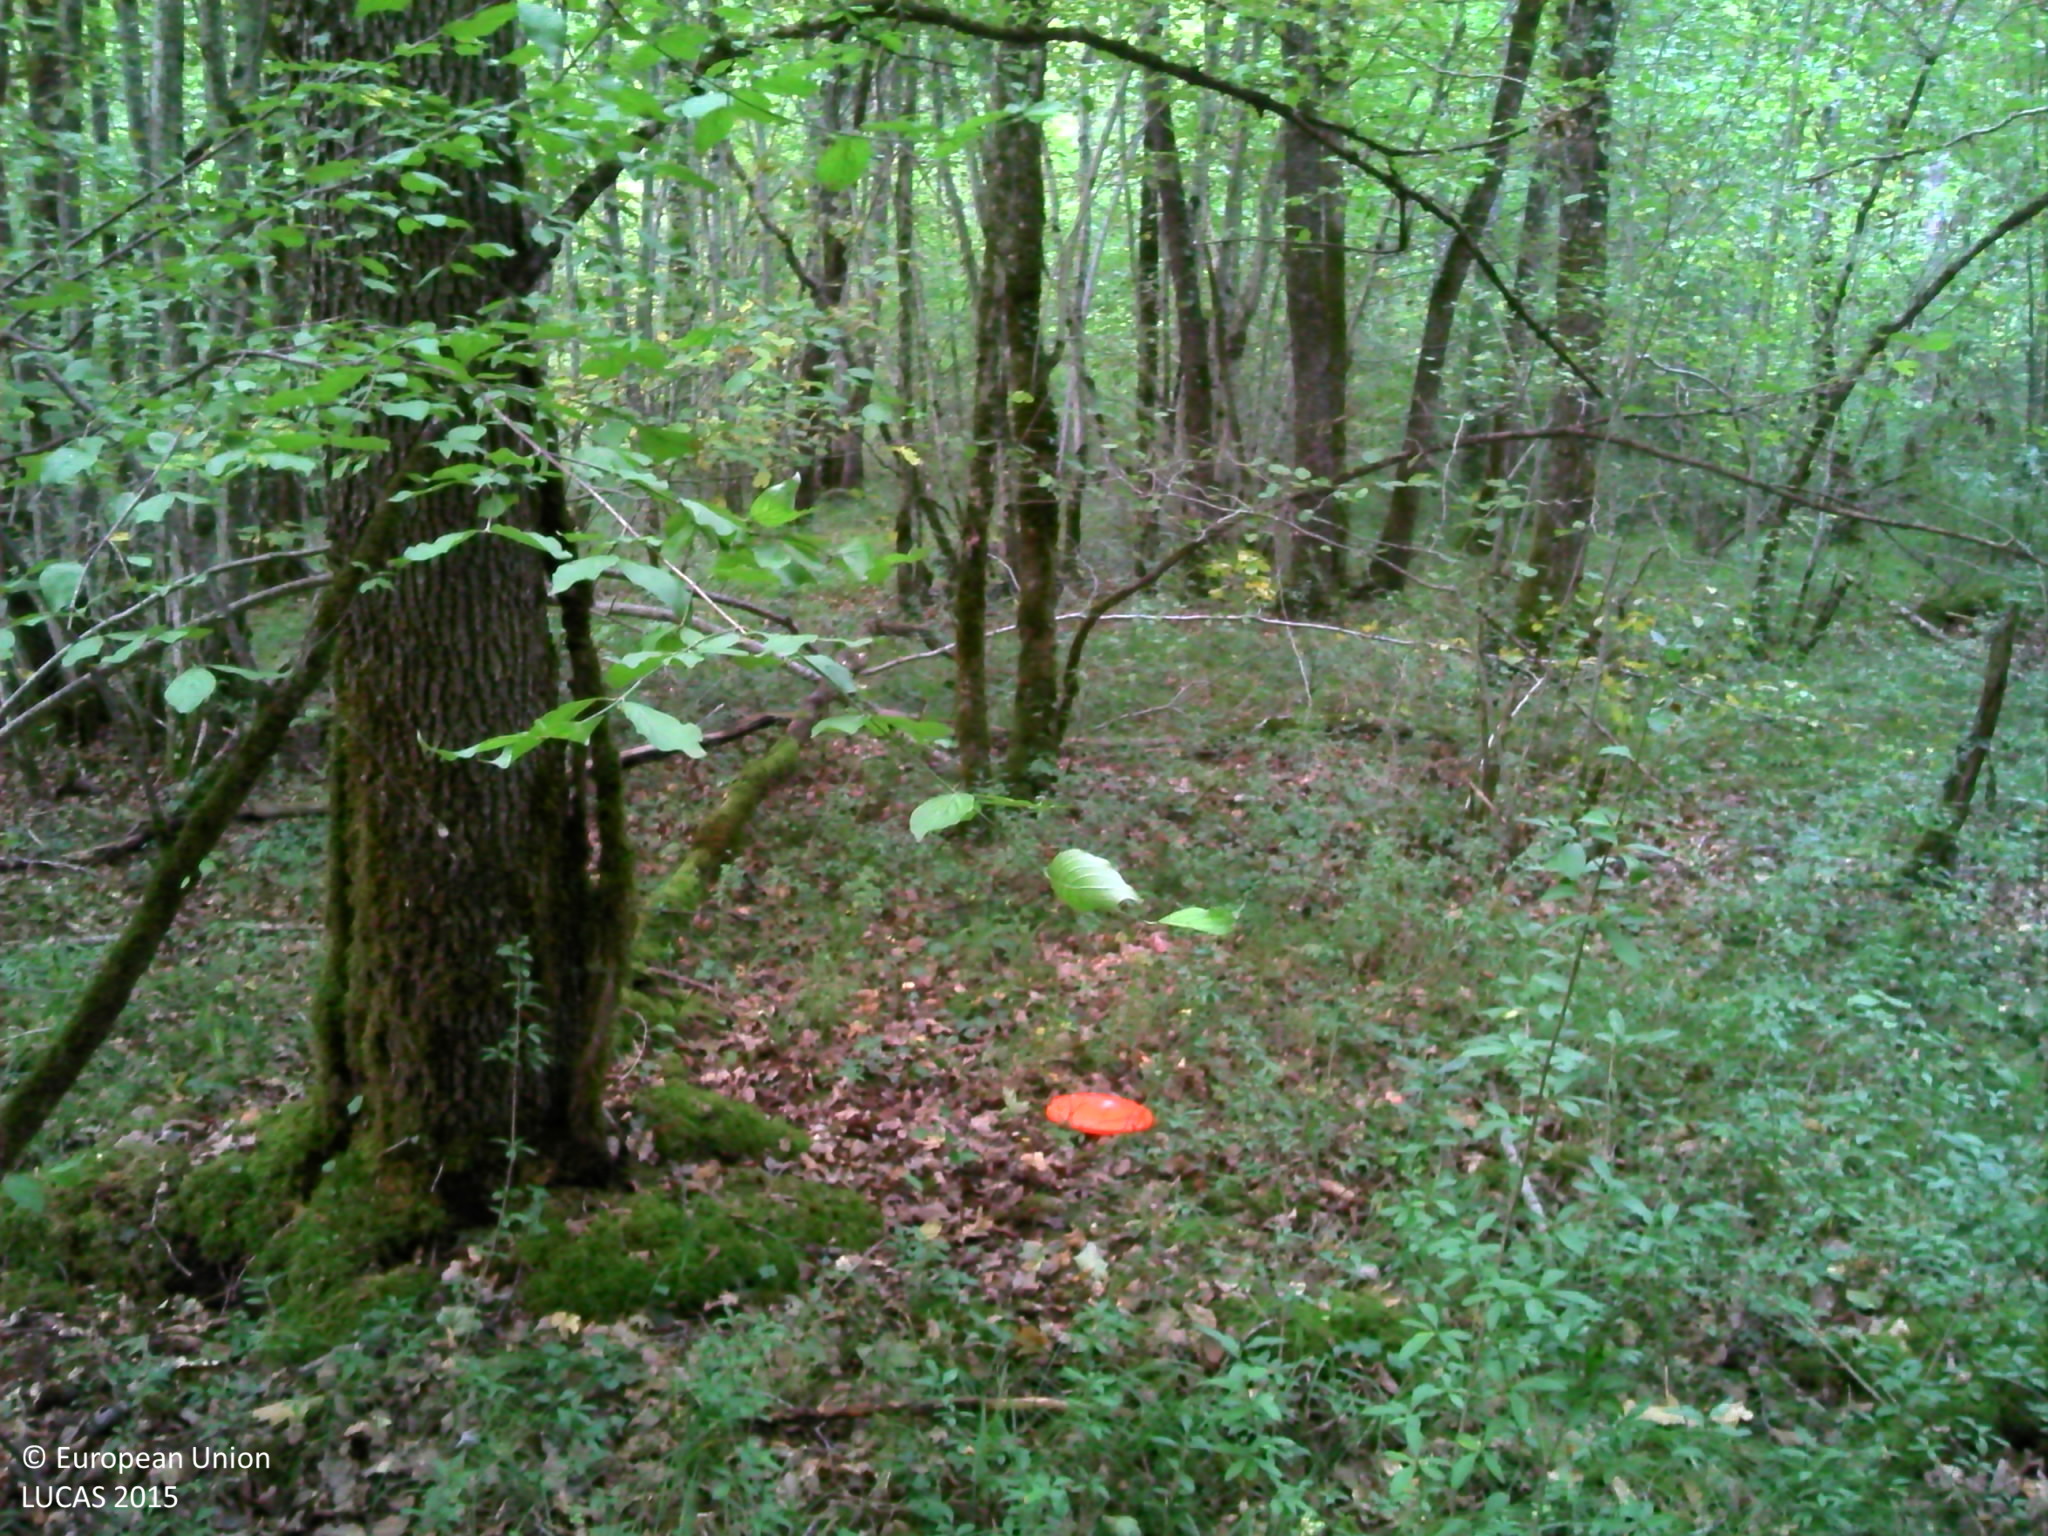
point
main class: Woodland
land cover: Broadleaved woodland
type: mesophytic deciduous forest
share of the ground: > 75 %
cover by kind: broadleaved forest trees 90 %, herbaceous plants 5 %, lichens and mosses 5 %
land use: Forestry
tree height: > 5 m
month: September
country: FR
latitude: 47.5959
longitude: 4.7995
